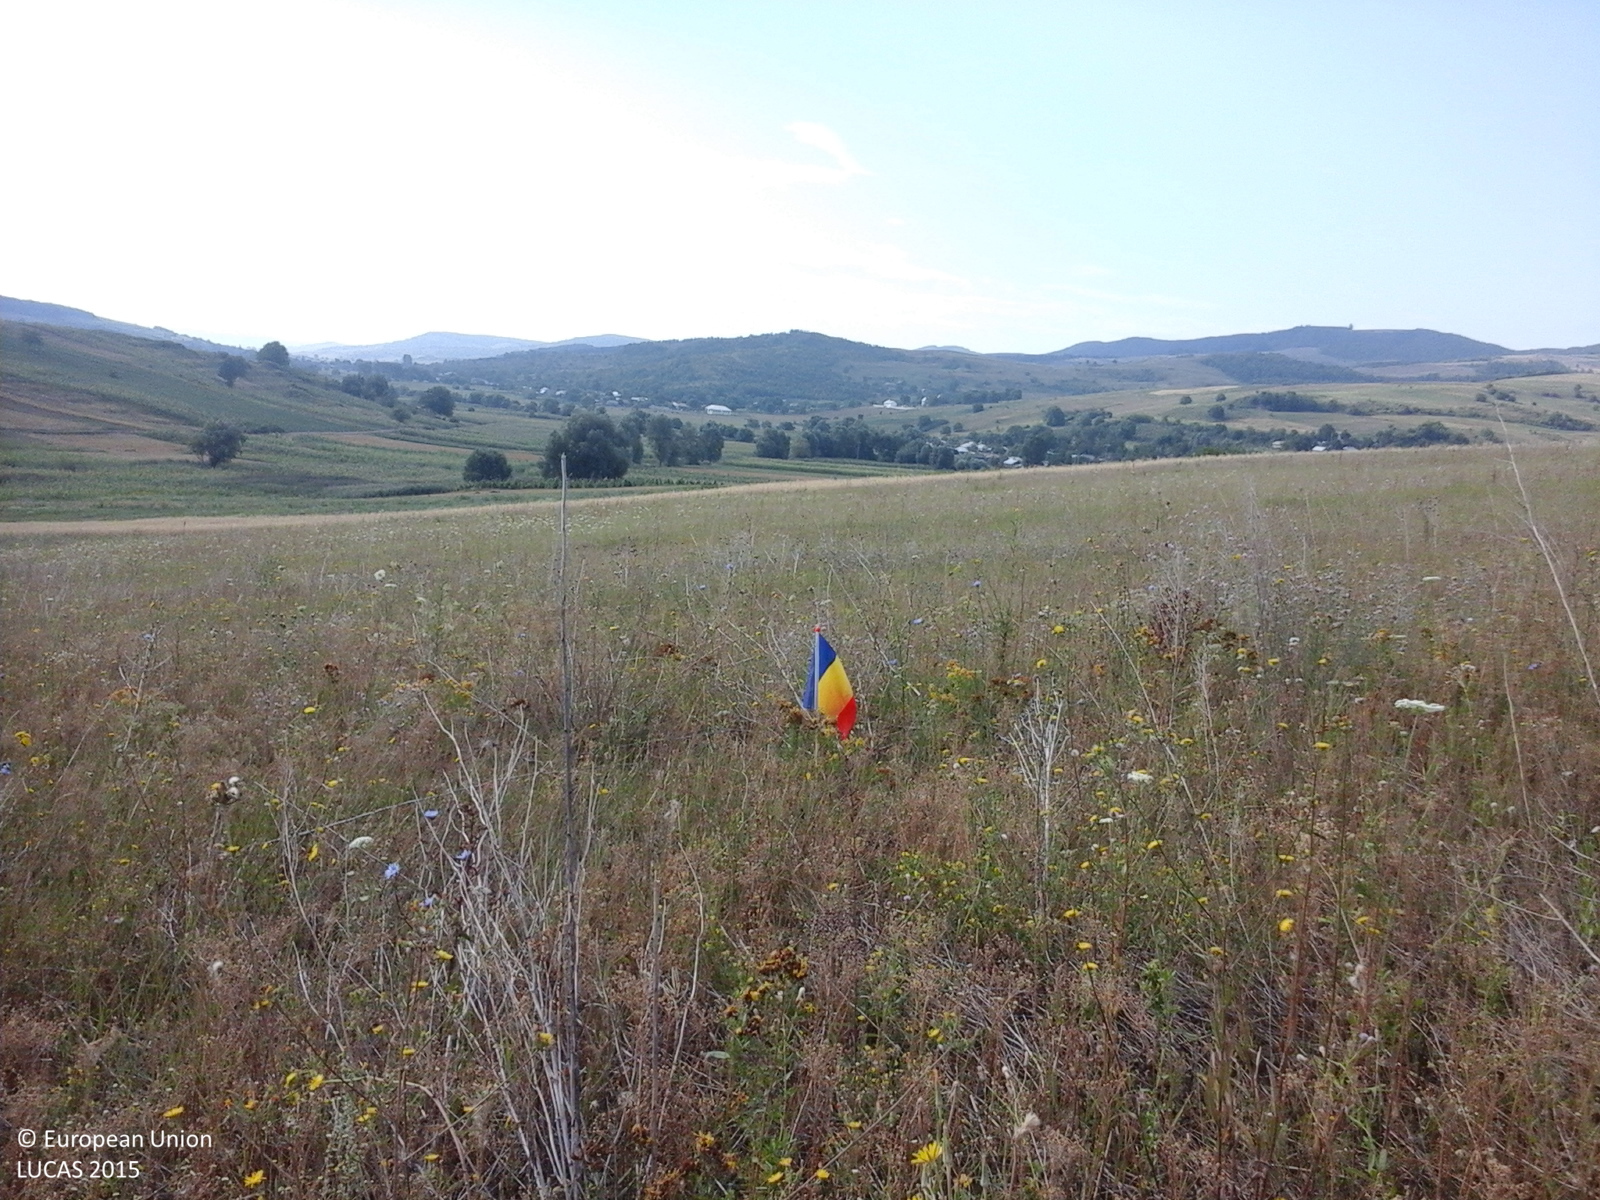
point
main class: Grassland
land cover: Spontaneously vegetated surfaces
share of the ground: > 75 %
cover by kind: herbaceous plants 100 %
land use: Semi-natural and natural areas not in use
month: July
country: RO
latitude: 46.6634
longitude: 27.2650
